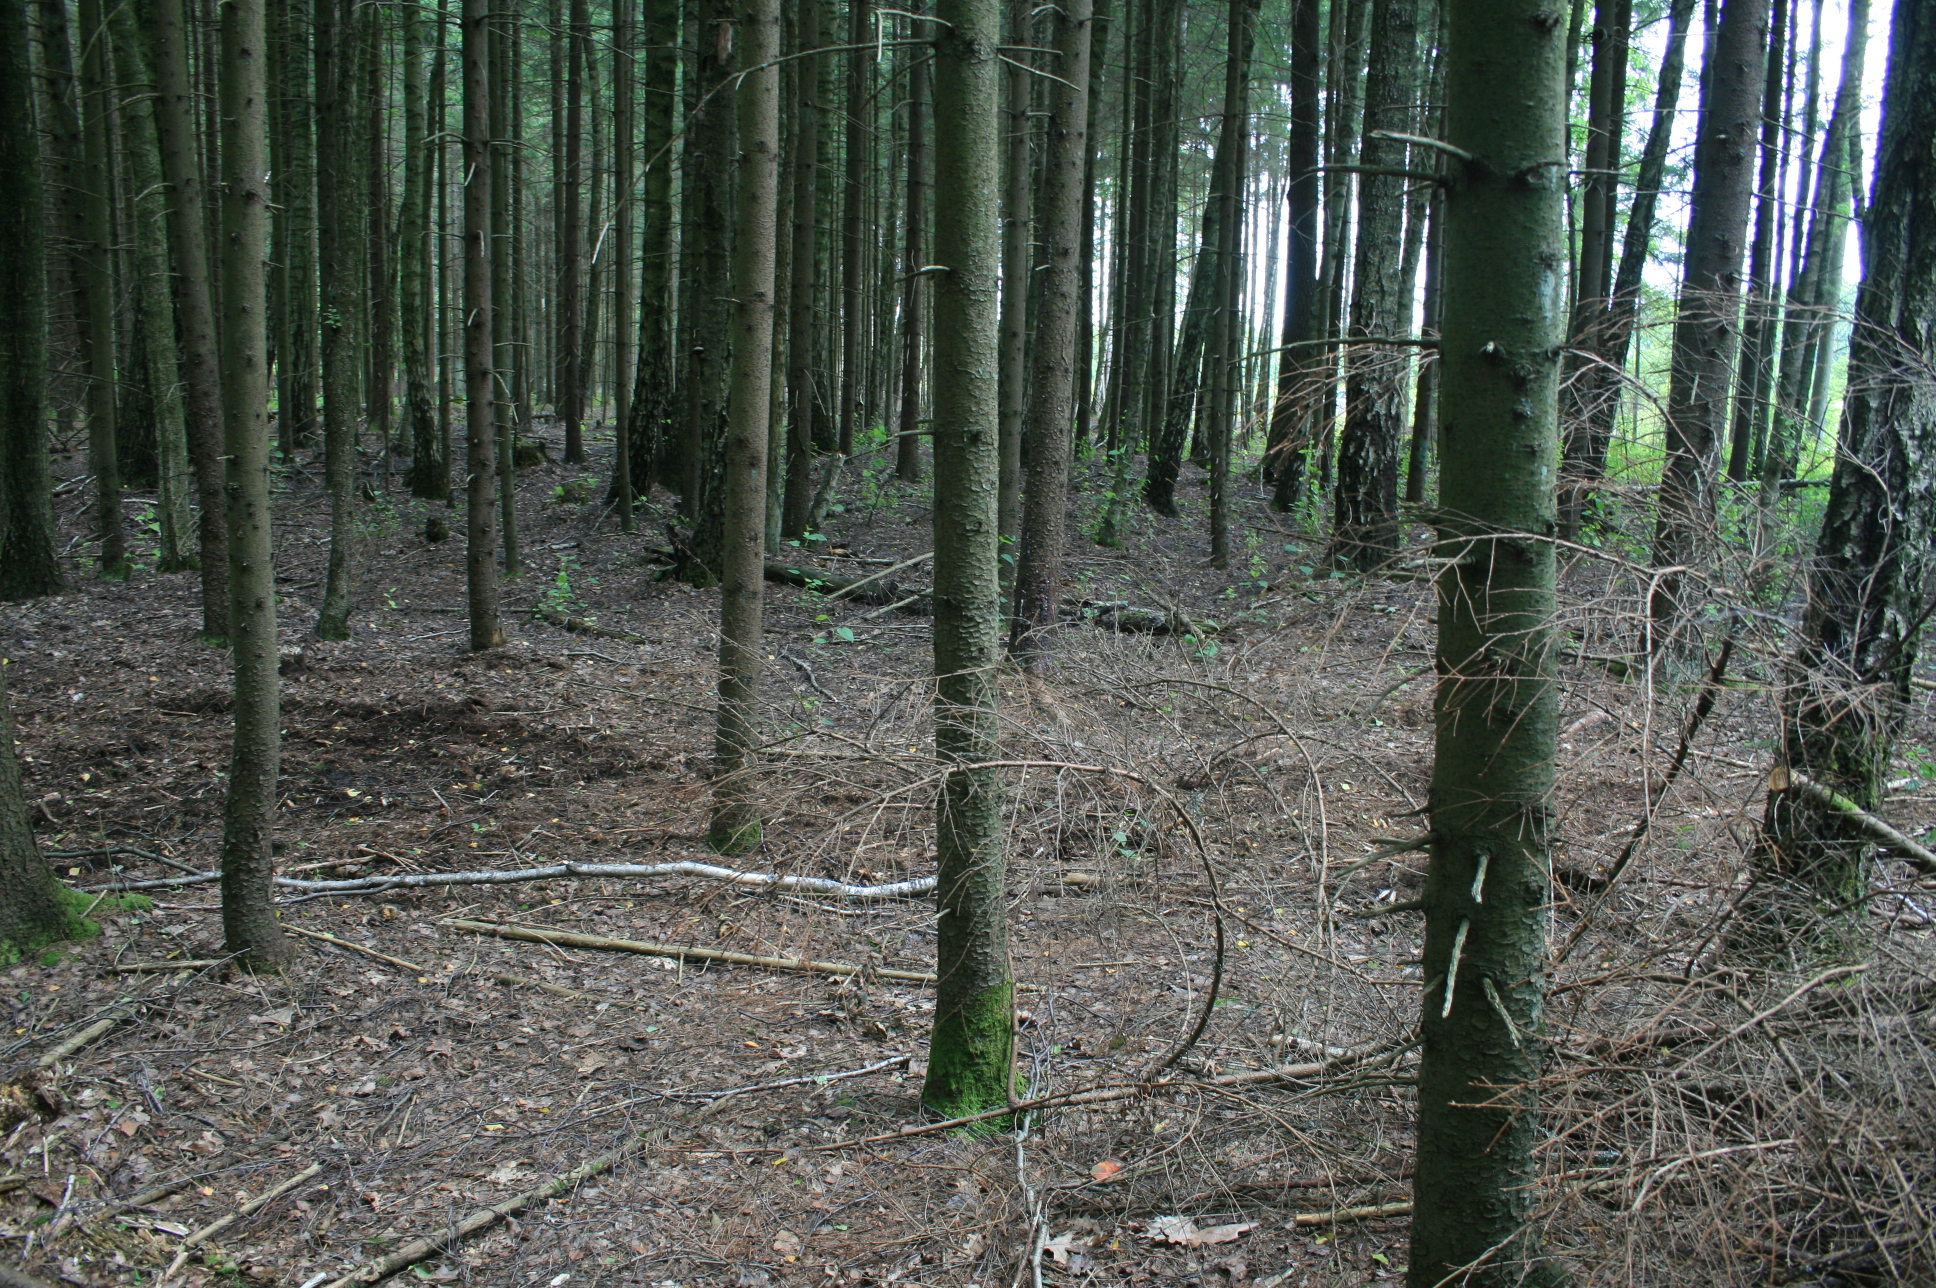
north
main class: Woodland
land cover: Spruce dominated mixed woodland
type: hemiboreal forest and nemoral coniferous forest and mixed broadleaved-coniferous forest
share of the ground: > 75 %
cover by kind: coniferous forest trees 65 %, broadleaved forest trees 30 %, herbaceous plants 5 %
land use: Forestry
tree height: > 5 m
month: July
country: LT
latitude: 55.4798
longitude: 21.7743
